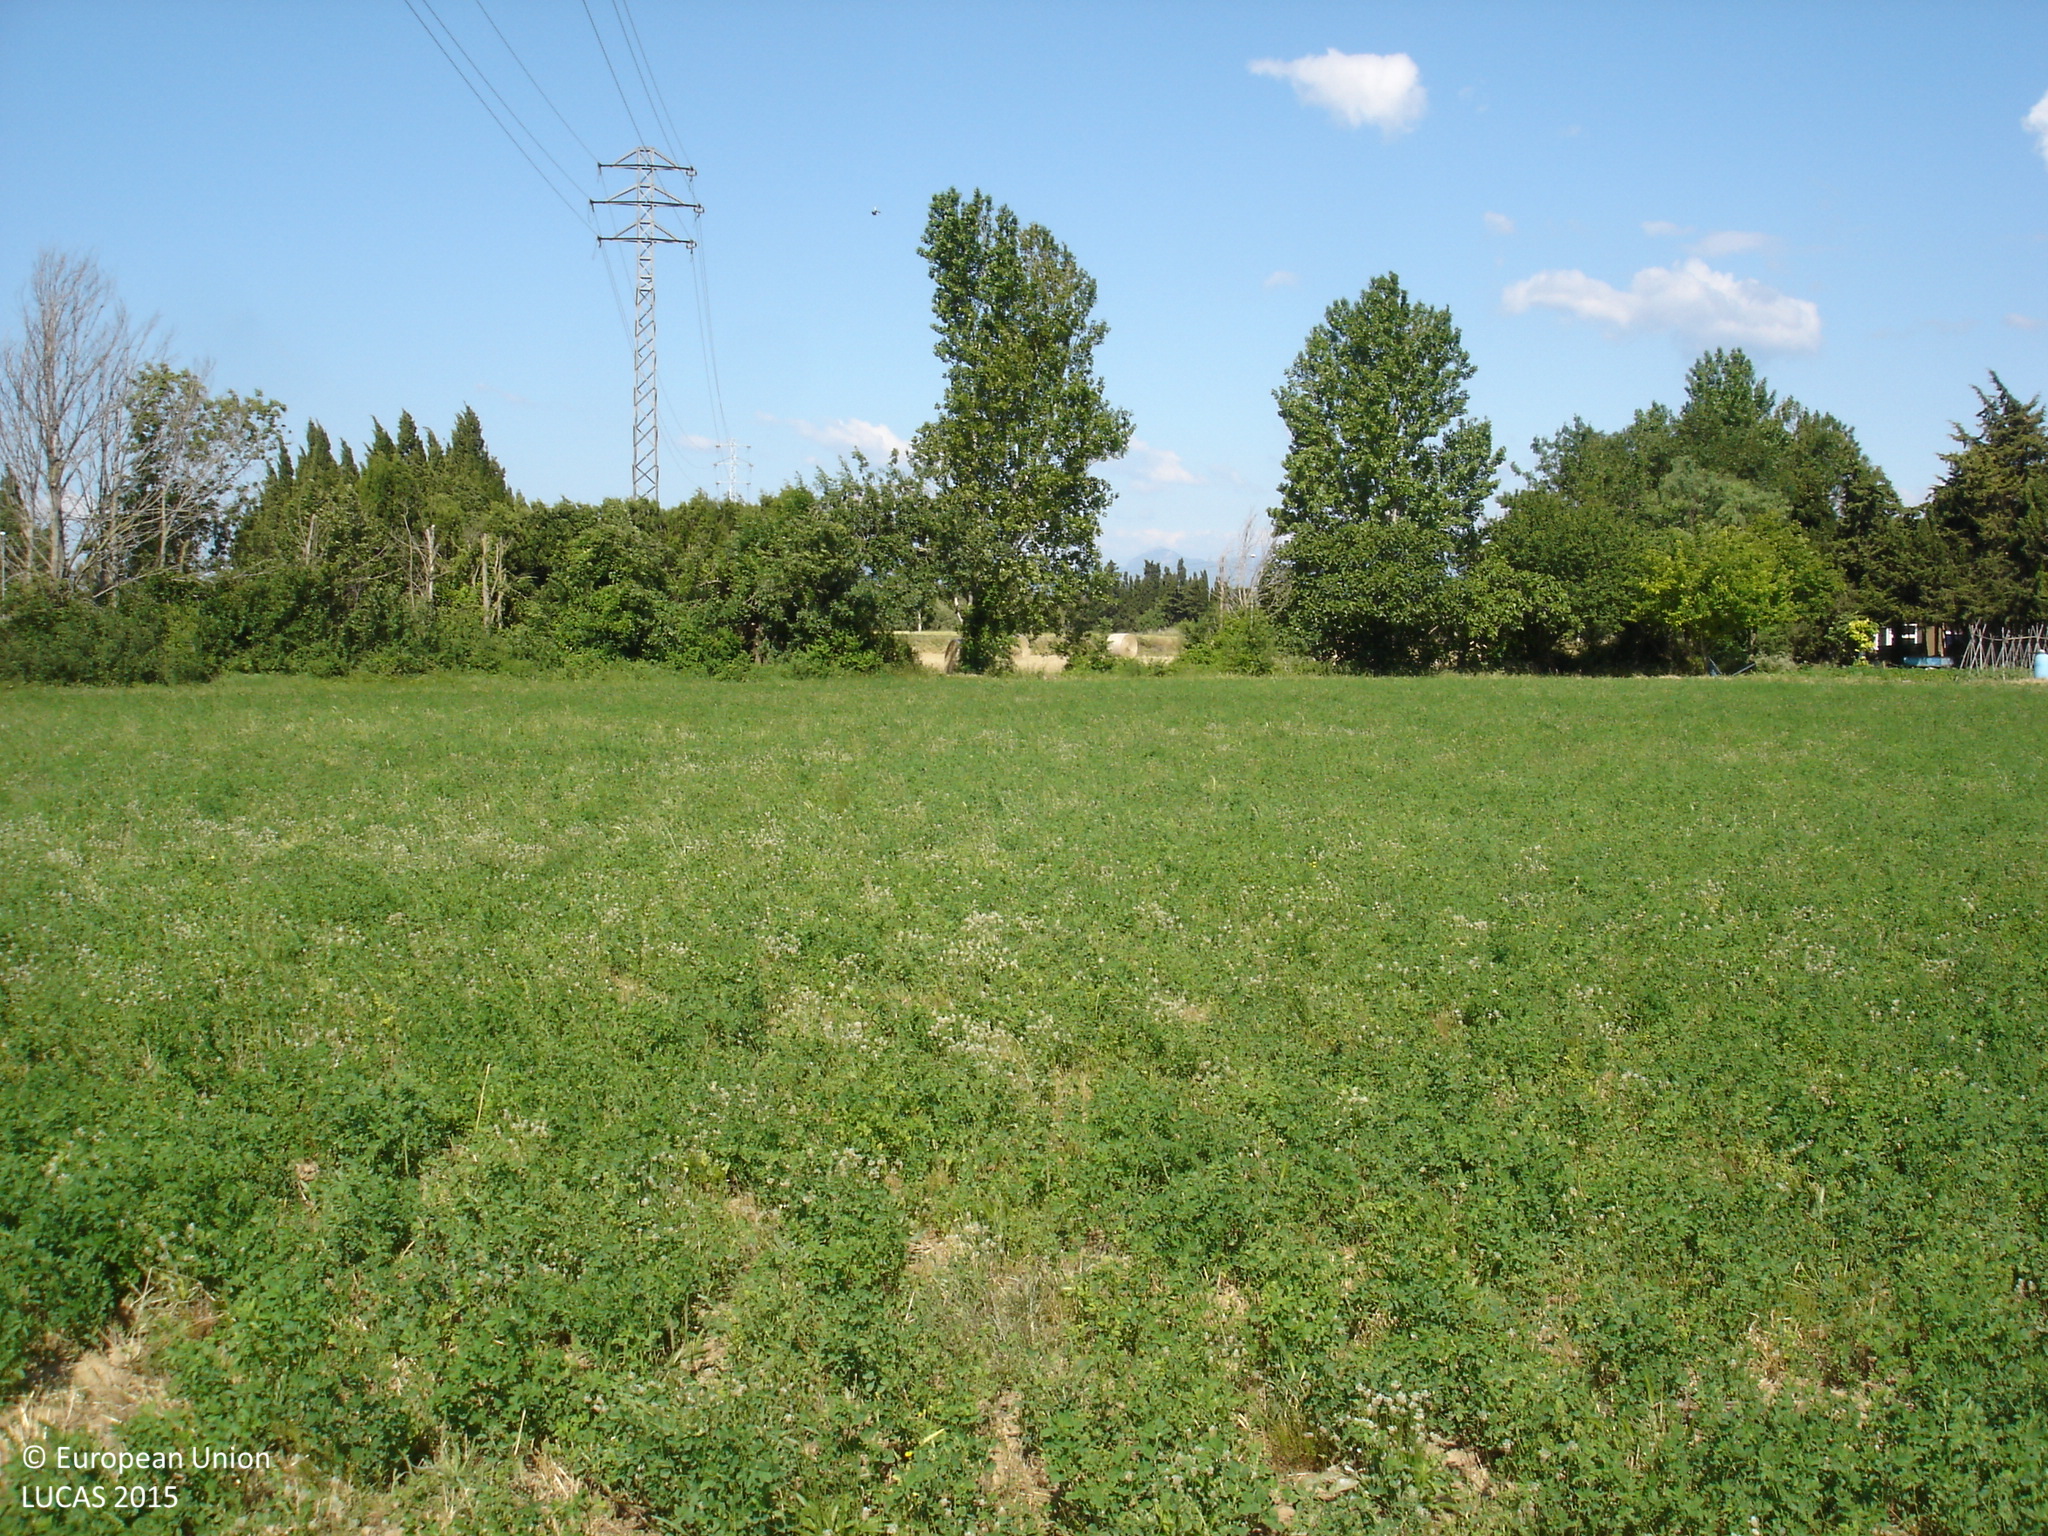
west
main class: Cropland
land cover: Lucerne
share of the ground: > 75 %
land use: Agriculture (excluding fallow land and kitchen gardens)
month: May
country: ES
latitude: 42.2484
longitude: 2.9969
